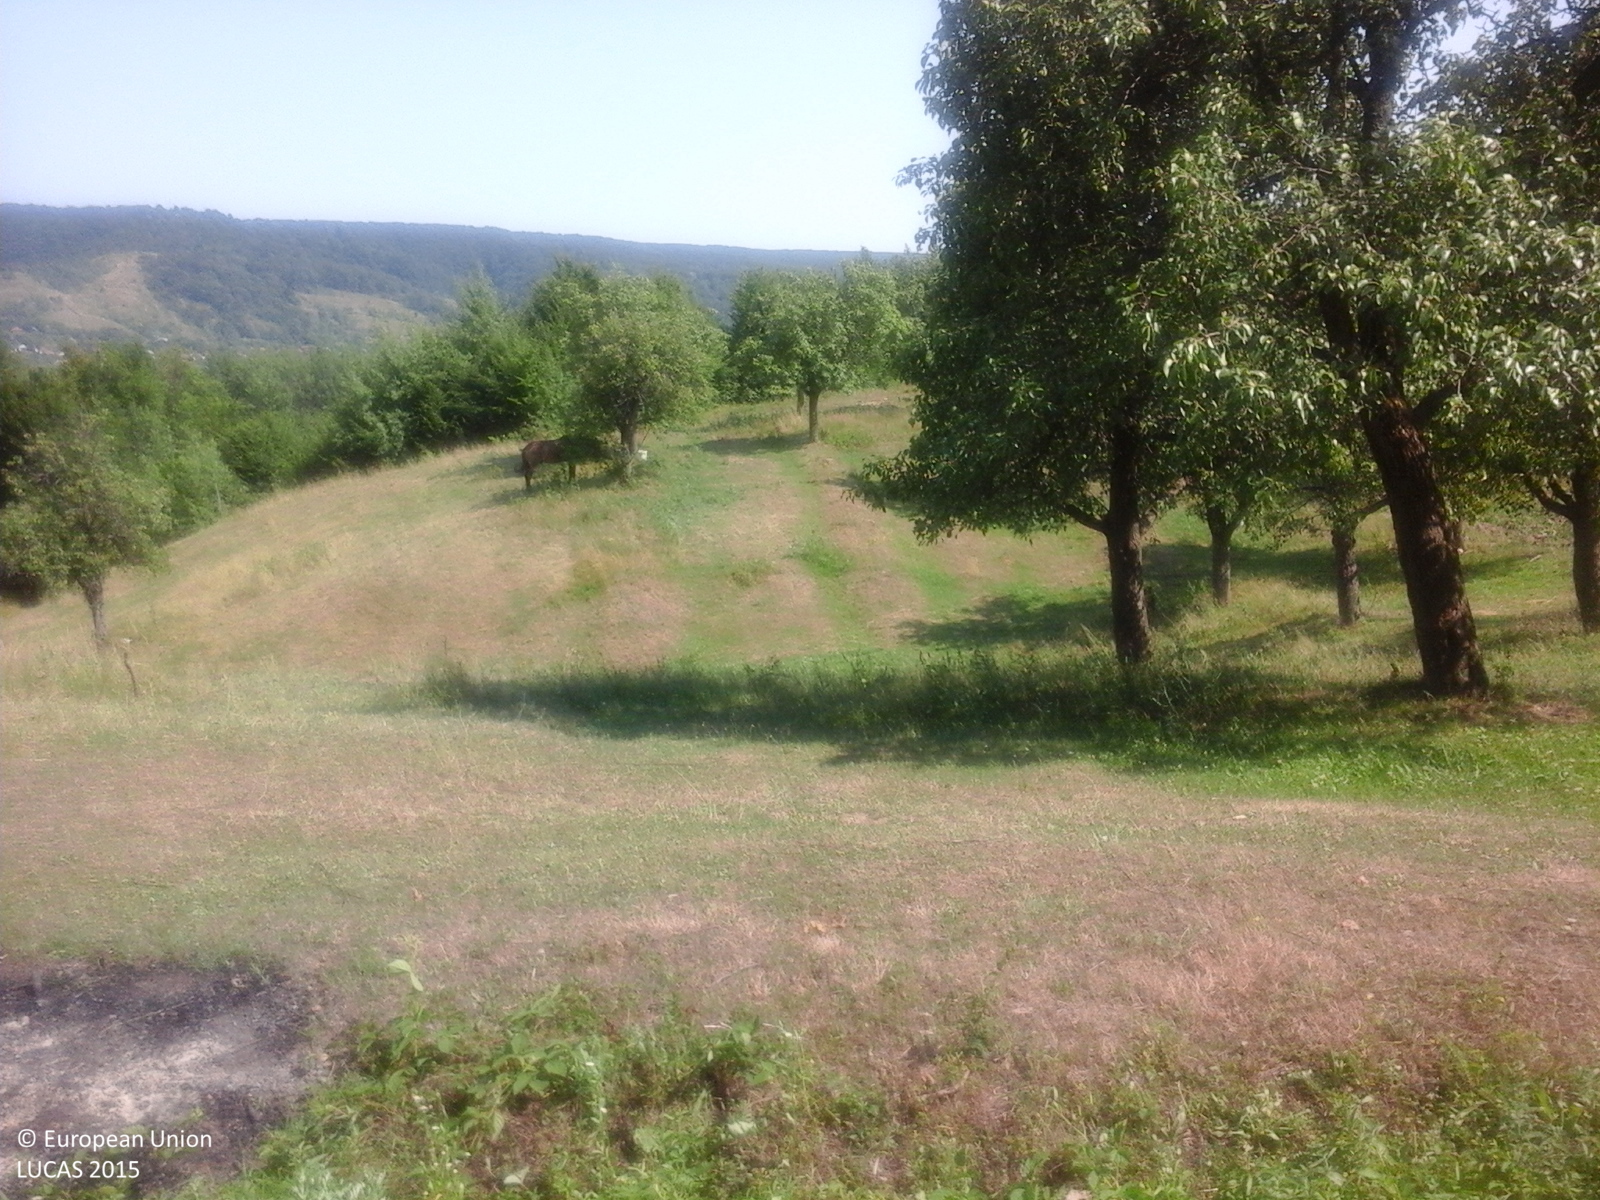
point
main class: Cropland
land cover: Pear fruit
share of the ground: > 75 %
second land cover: Grassland without tree/shrub cover
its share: > 75 %
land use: Agriculture (excluding fallow land and kitchen gardens)
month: July
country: RO
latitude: 45.0267
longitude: 24.7653
